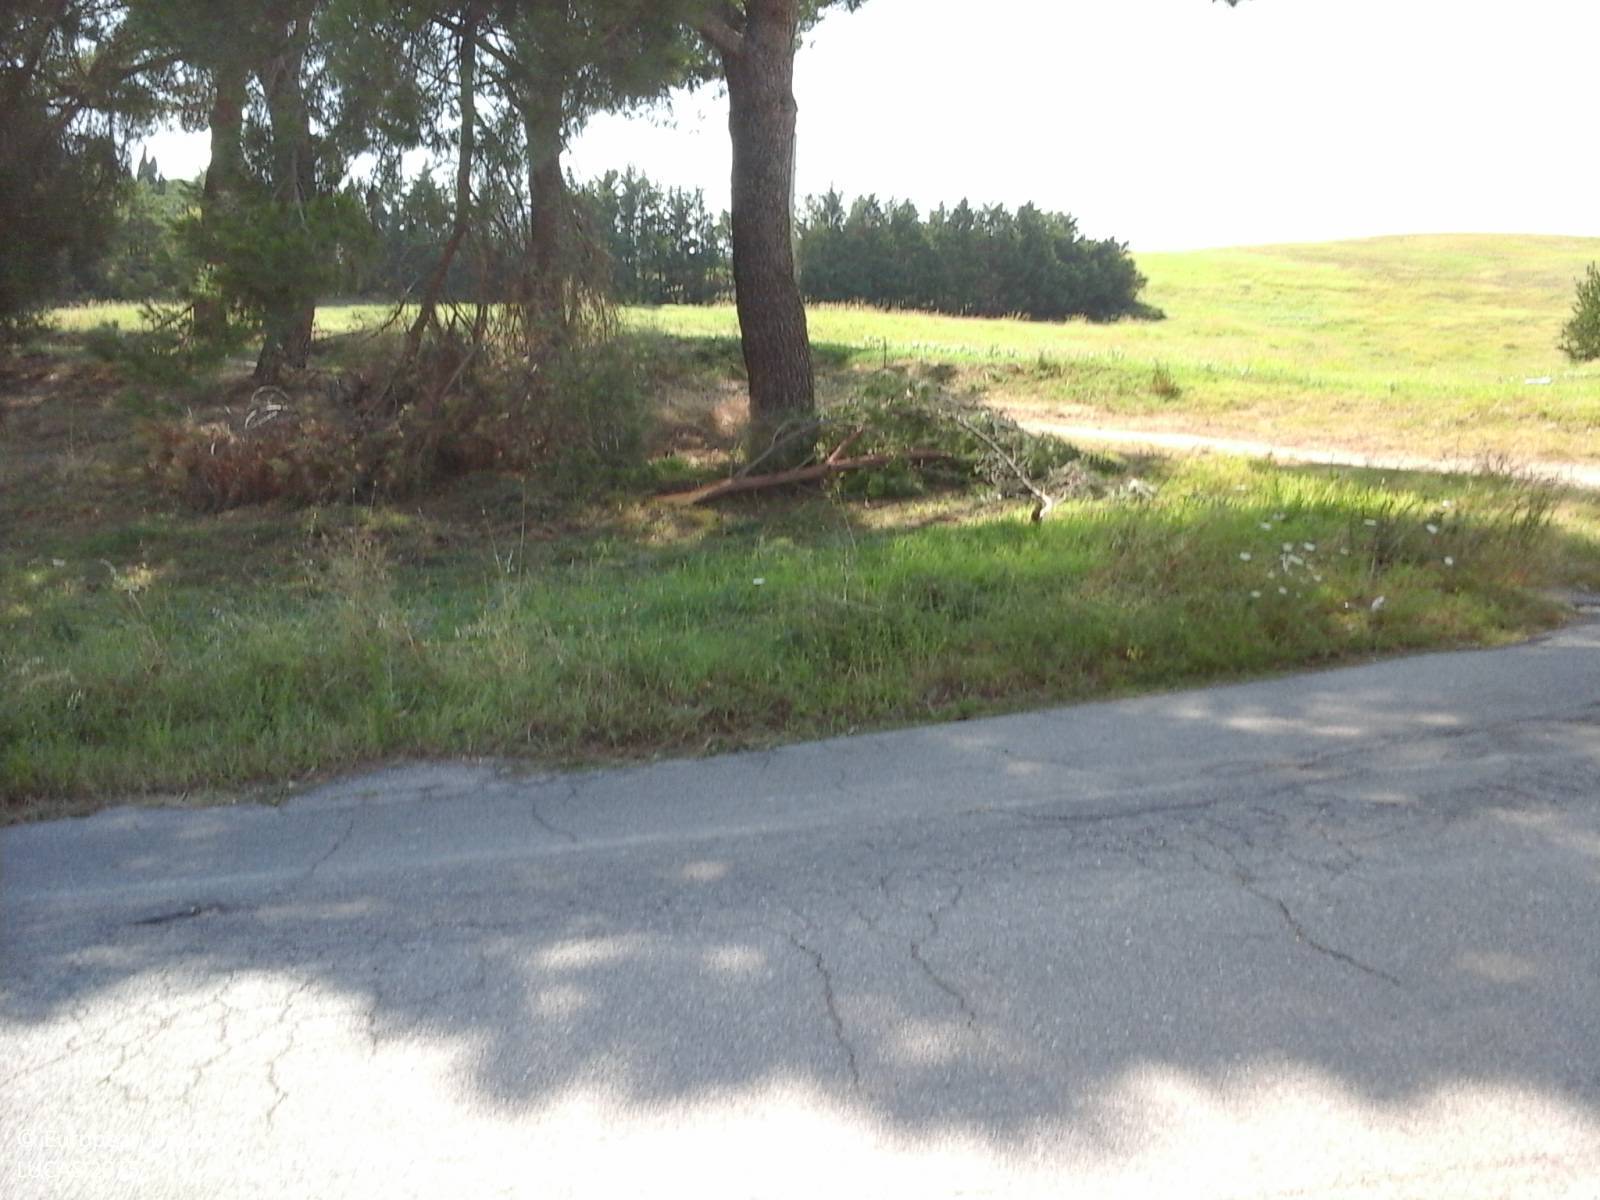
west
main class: Grassland
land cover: Grassland without tree/shrub cover
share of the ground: > 75 %
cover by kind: herbaceous plants 100 %
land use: Agriculture (excluding fallow land and kitchen gardens)
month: July
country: IT
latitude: 42.0974
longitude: 12.5663
